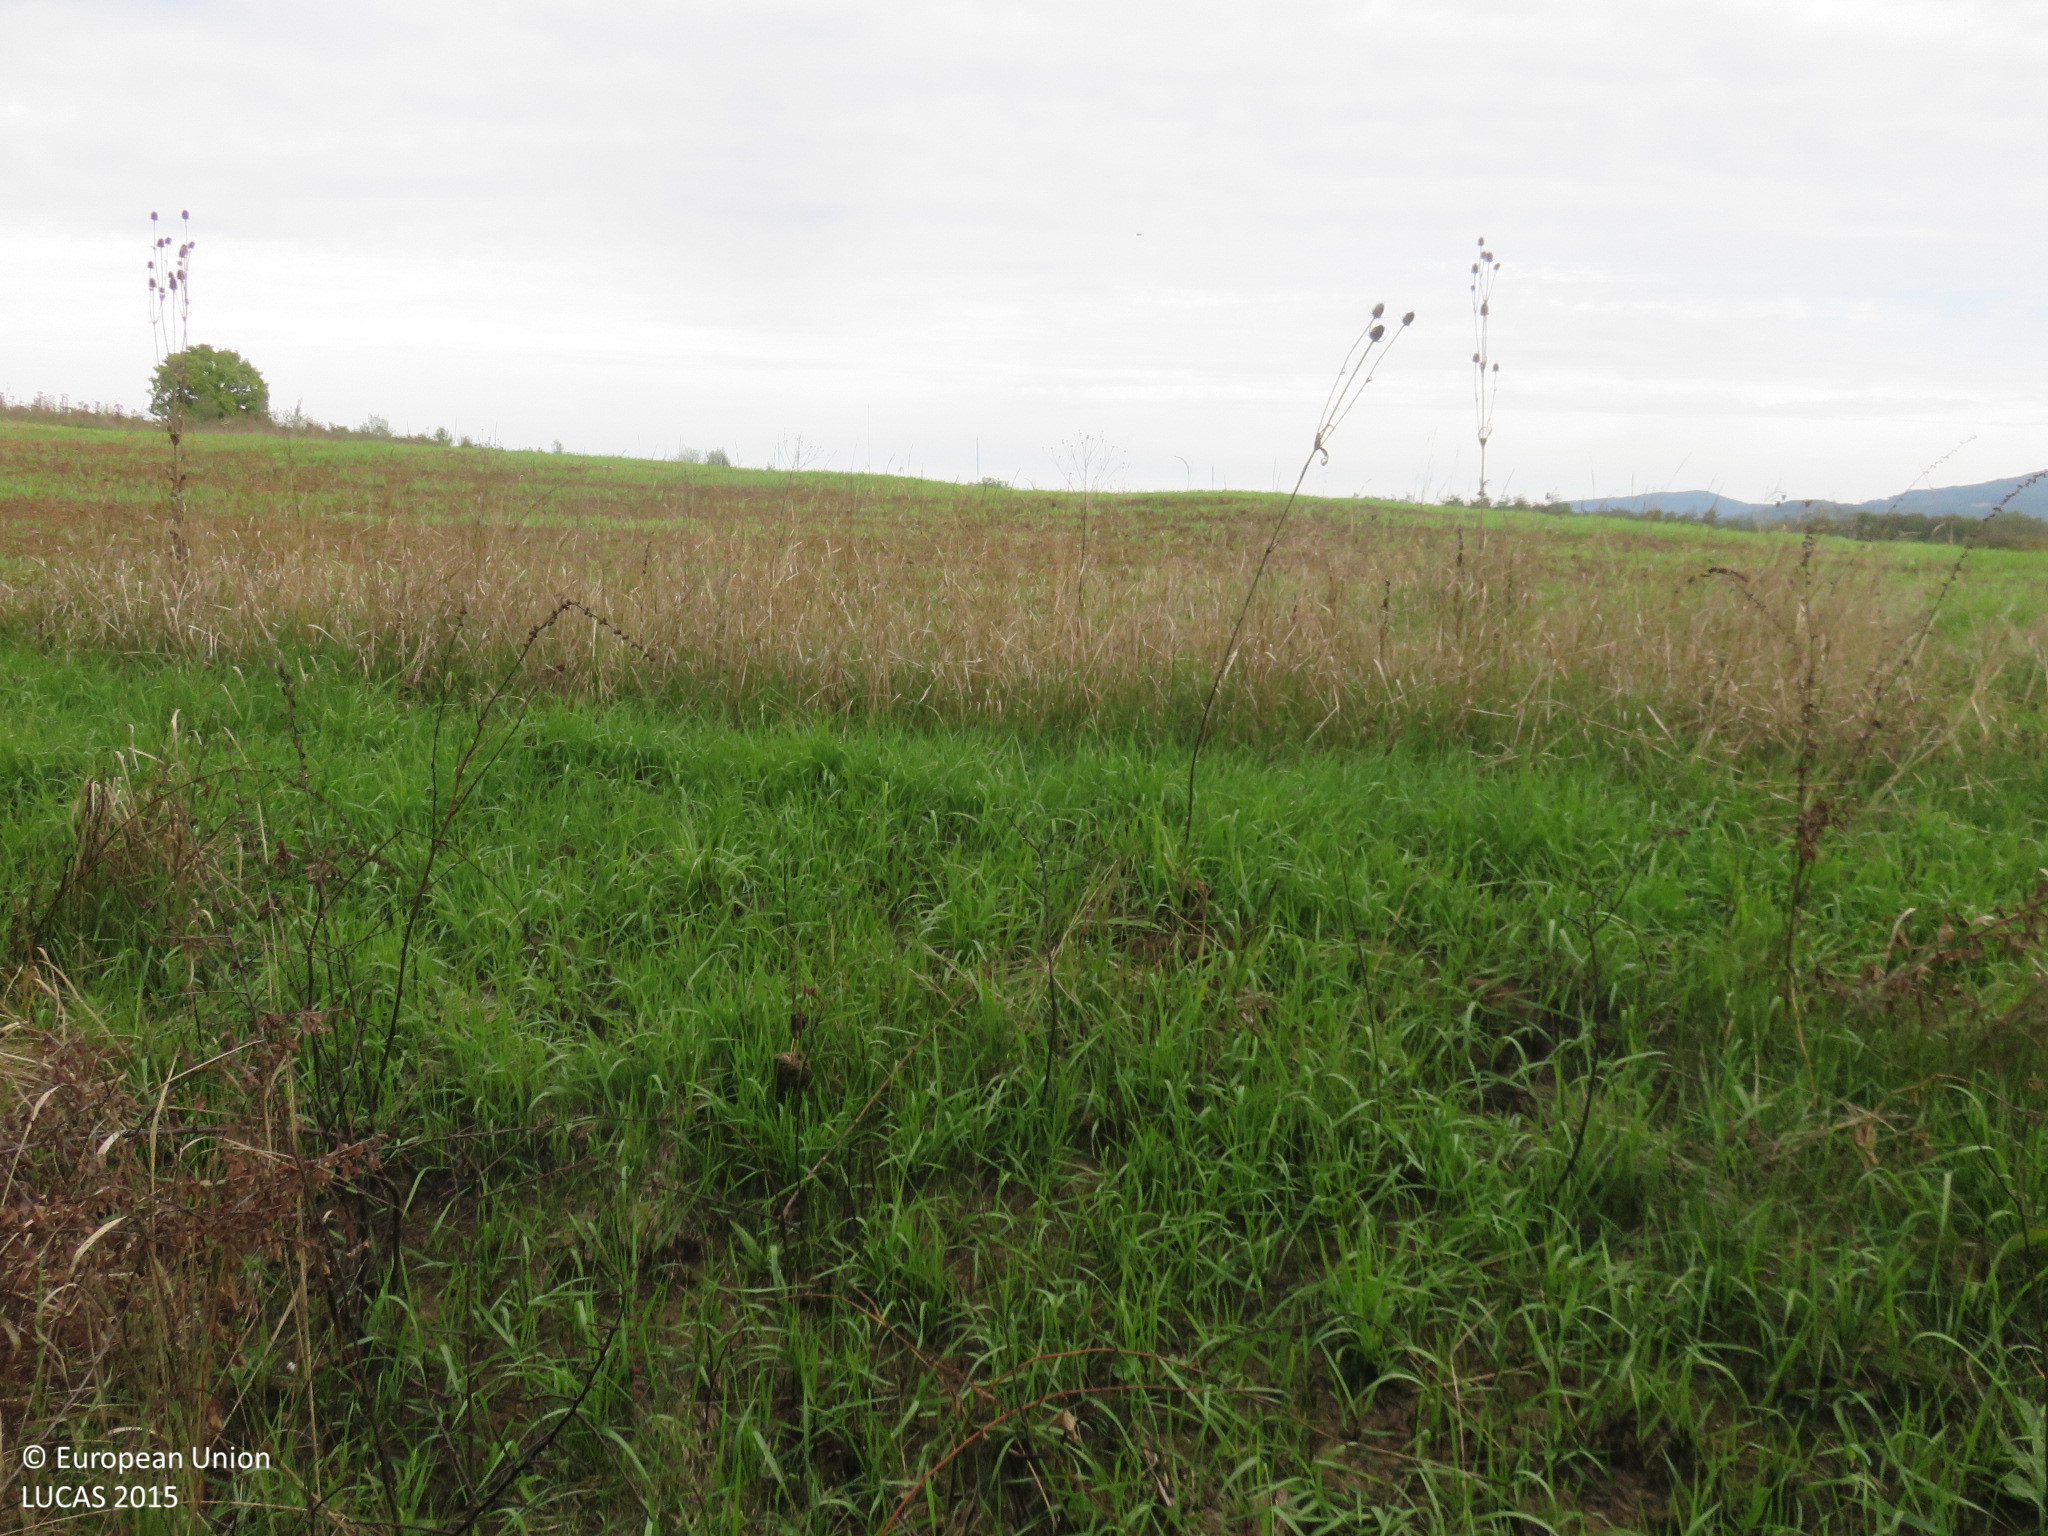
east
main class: Shrubland
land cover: Shrubland with sparse tree cover
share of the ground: > 75 %
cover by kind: shrubs 90 %, broadleaved forest trees 5 %, herbaceous plants 5 %
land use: Semi-natural and natural areas not in use
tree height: < 5 m
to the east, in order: Shrubland with sparse tree cover; Grass margins; Common wheat; Shrubland with sparse tree cover; Common wheat
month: October
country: BG
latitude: 43.0540
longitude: 24.8581
